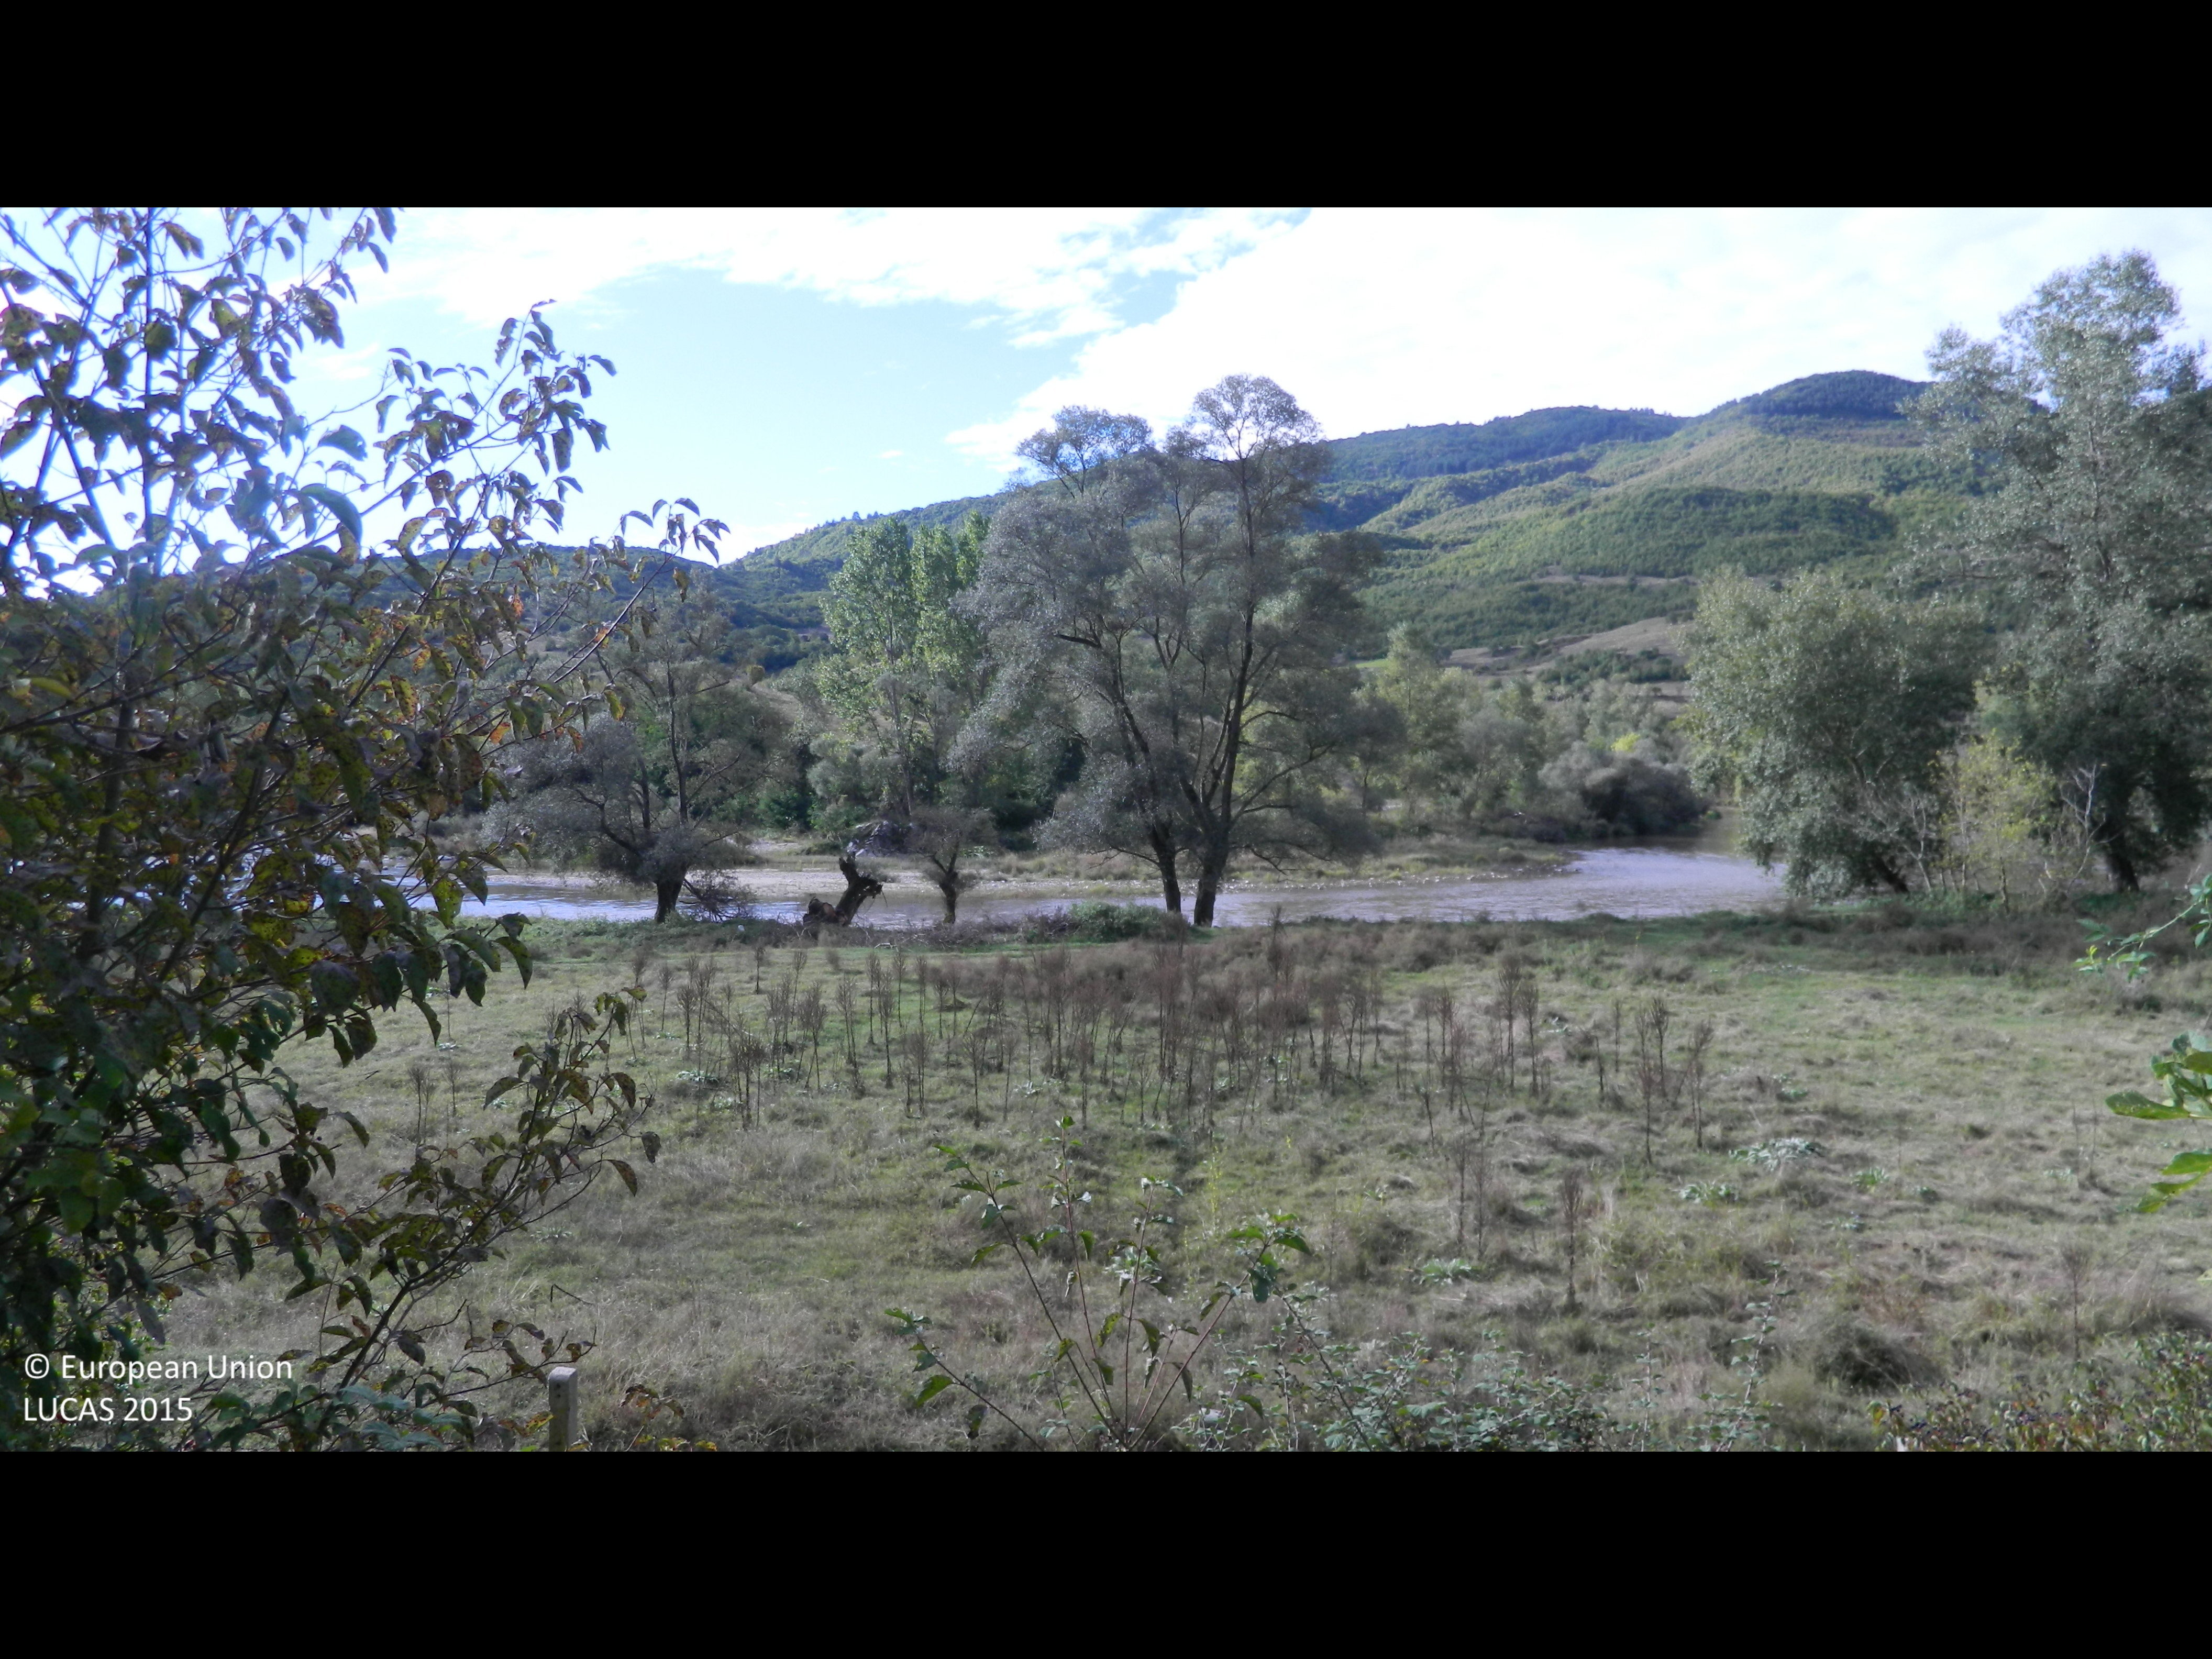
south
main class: Shrubland
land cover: Shrubland with sparse tree cover
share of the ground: > 75 %
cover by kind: shrubs 70 %, unconsolidated bare surface 15 %, herbaceous plants 10 %, broadleaved forest trees 5 %
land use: Abandoned areas
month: September
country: BG
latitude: 41.4741
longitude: 24.0057
